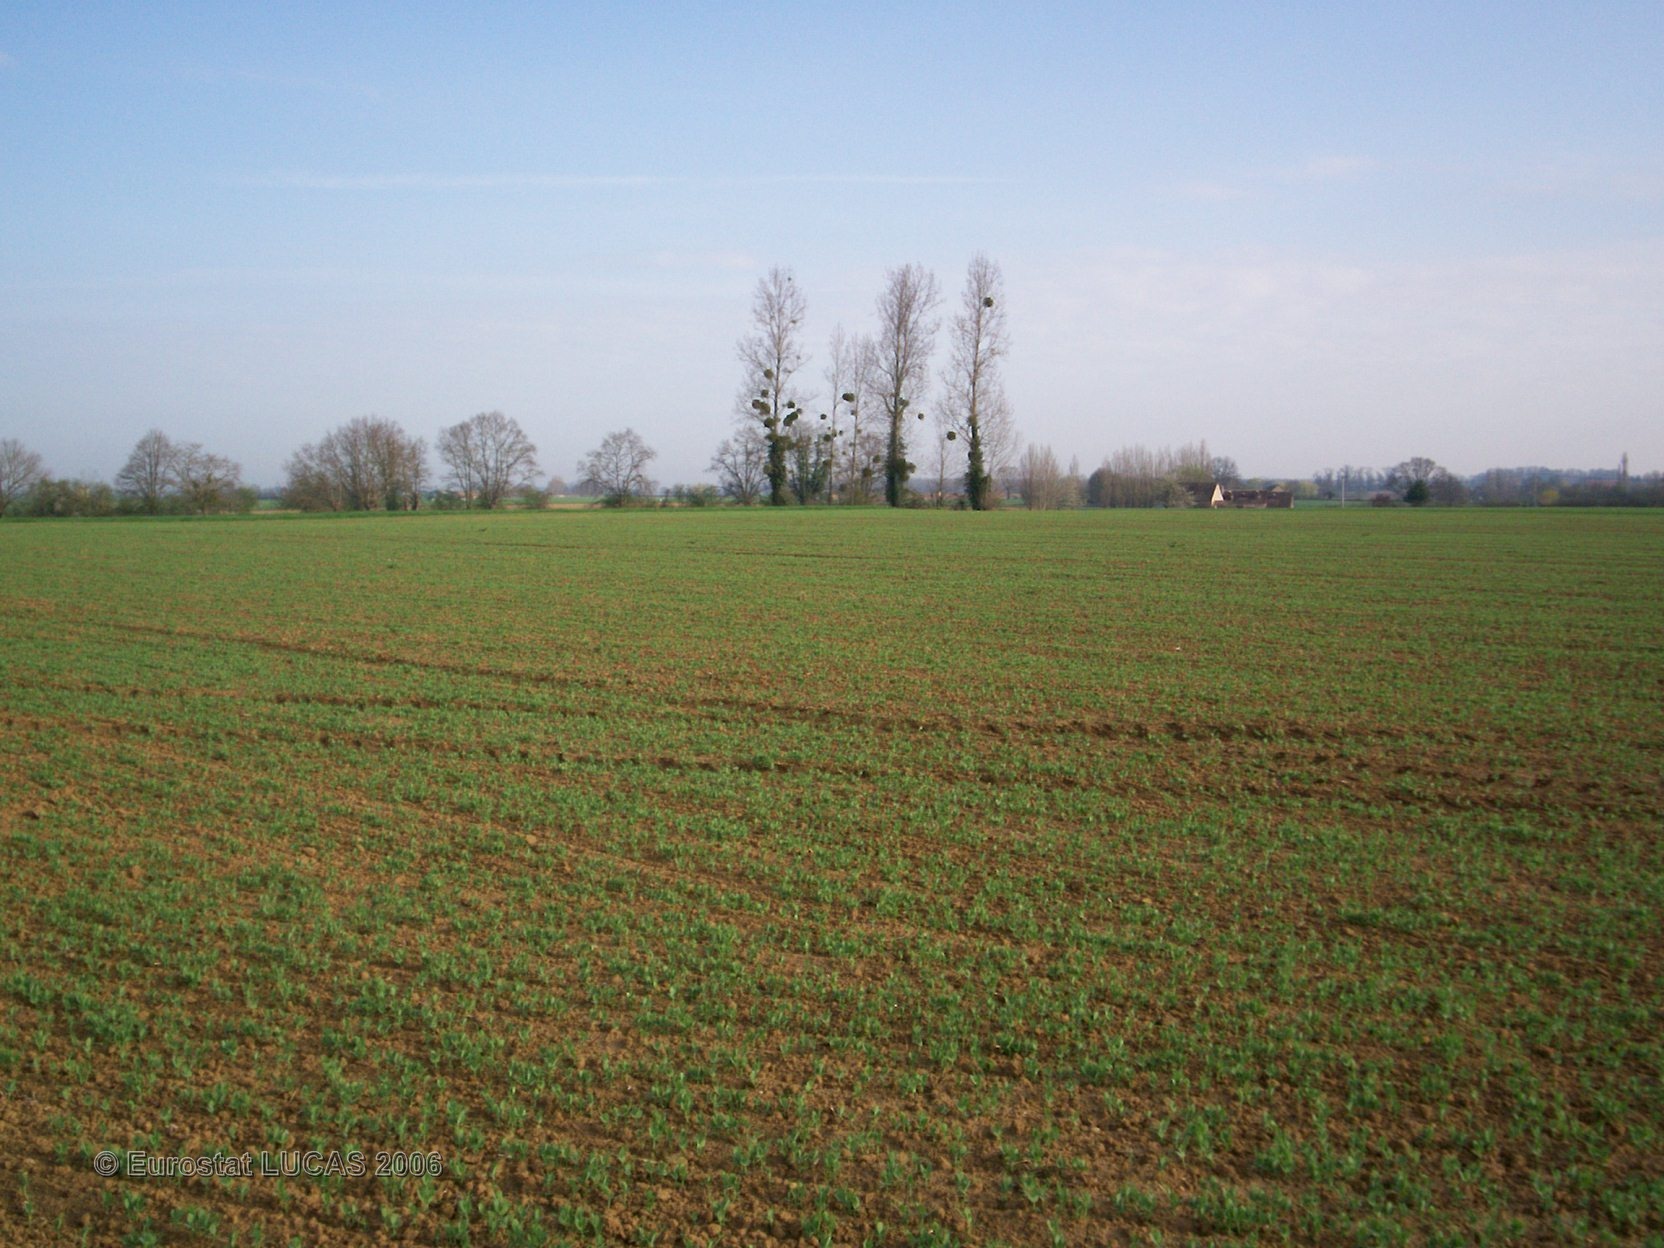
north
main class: Cropland
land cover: Dry pulses
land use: Agriculture (excluding fallow land and kitchen gardens)
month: April
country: FR
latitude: 48.2246
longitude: 0.2413
